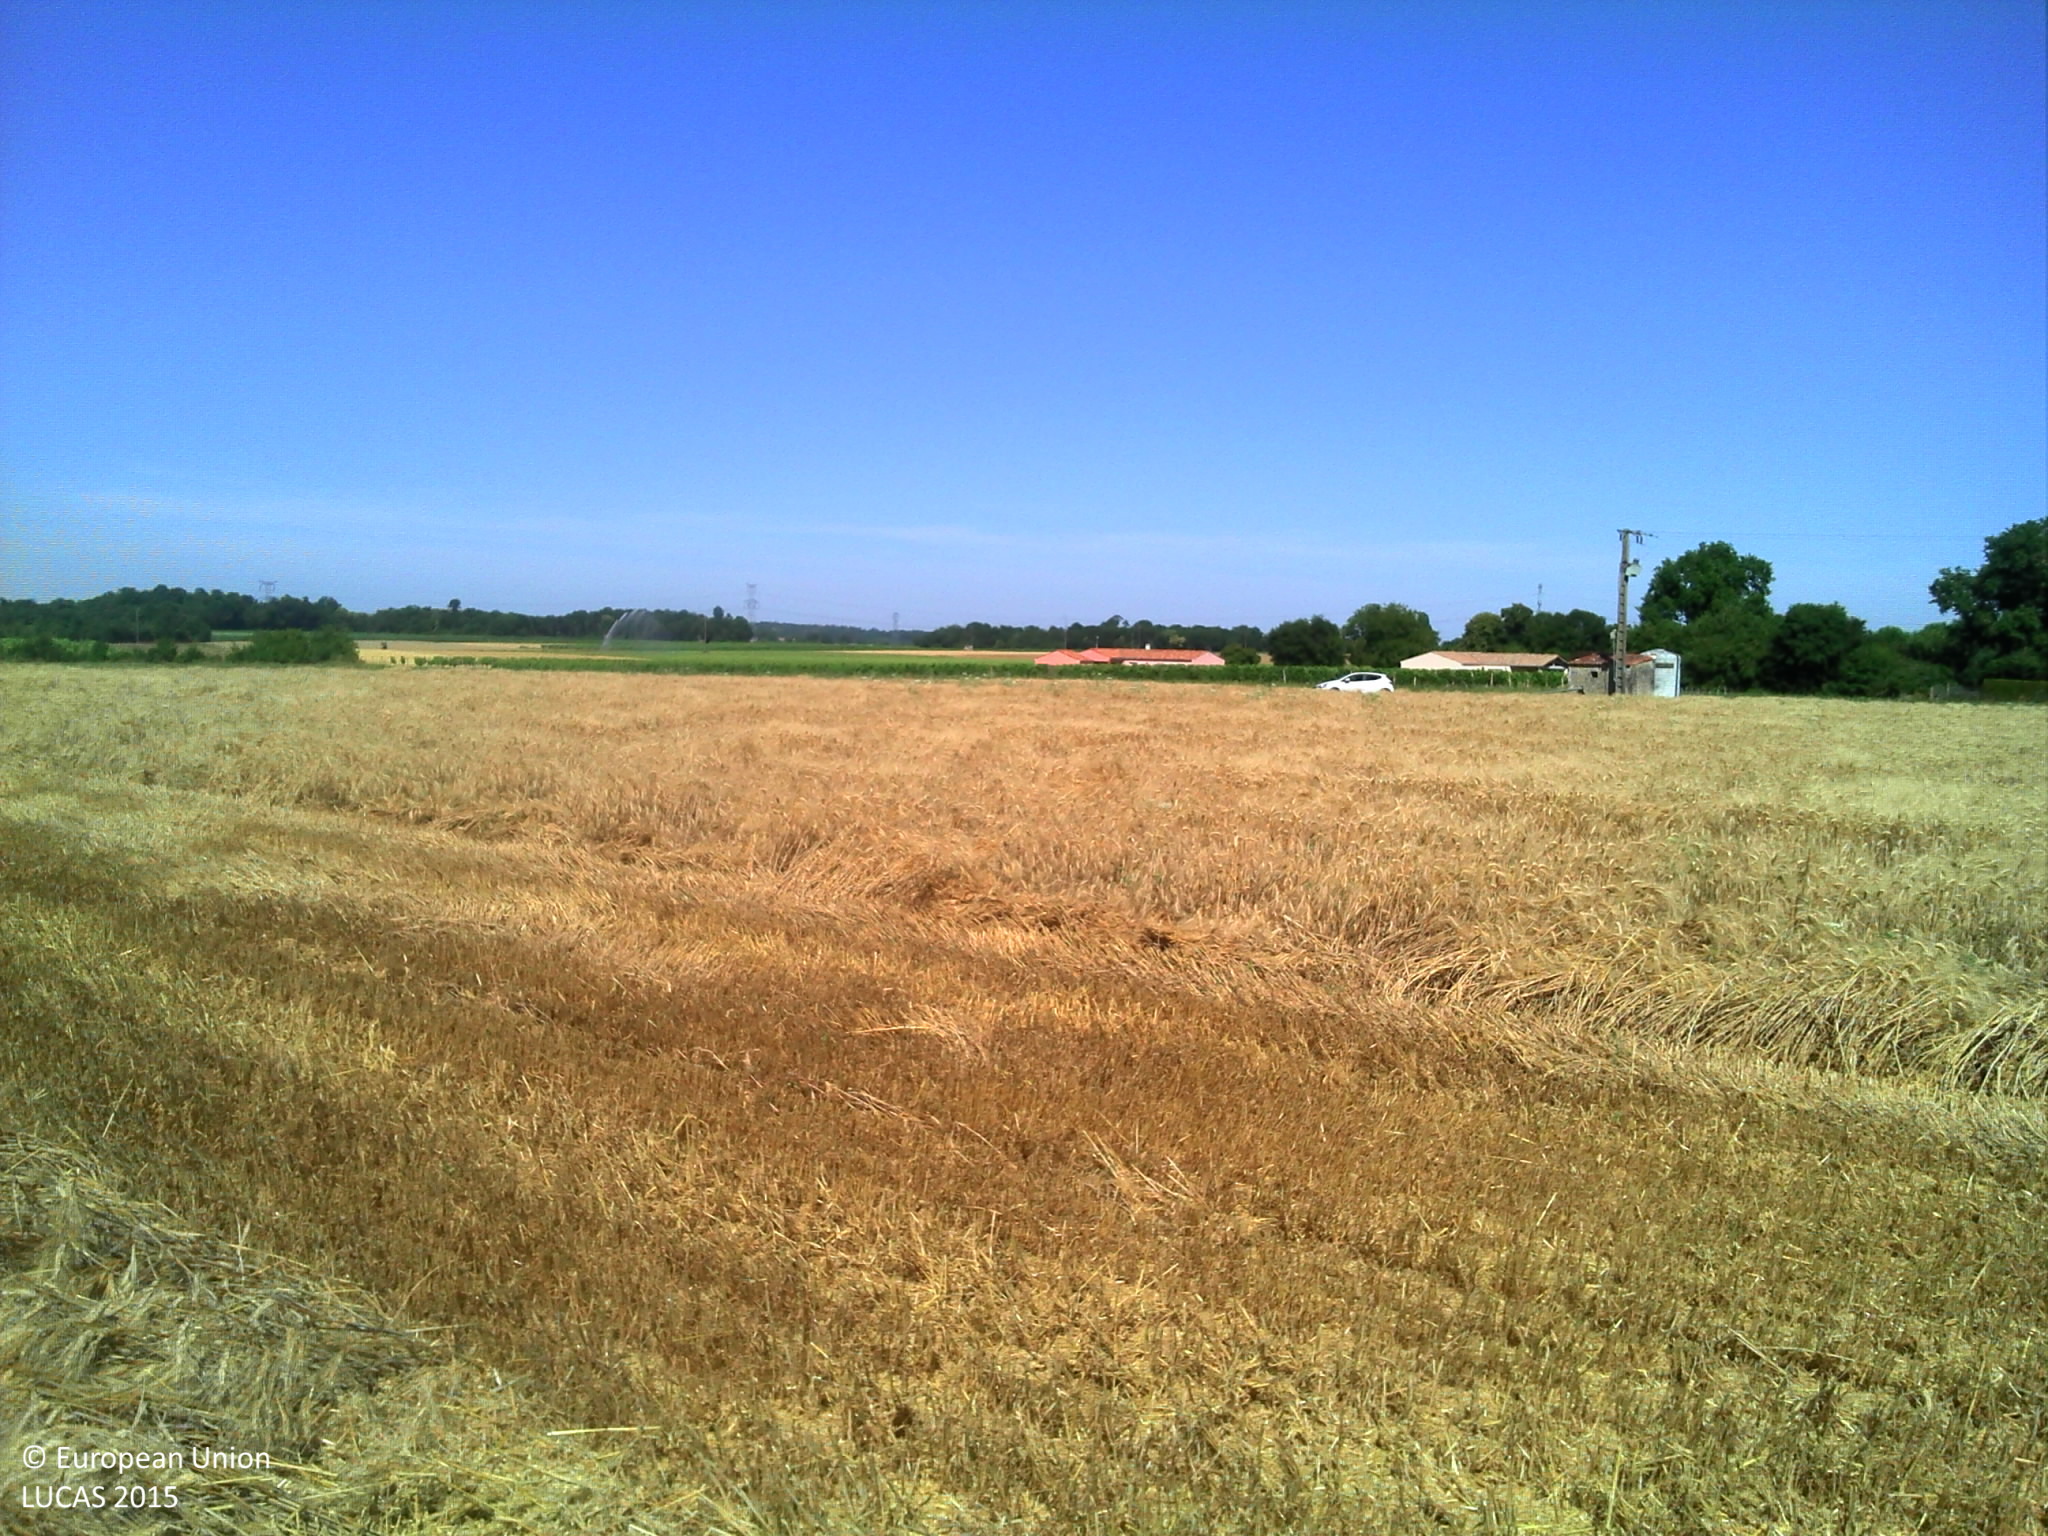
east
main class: Cropland
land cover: Common wheat
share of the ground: > 75 %
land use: Agriculture (excluding fallow land and kitchen gardens)
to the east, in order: Common wheat; Artificial constructions in urban areas; Grassland without tree/shrub cover; Vineyards; Grassland without tree/shrub cover; Artificial constructions in urban areas
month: June
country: FR
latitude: 45.5846
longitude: -0.6227
